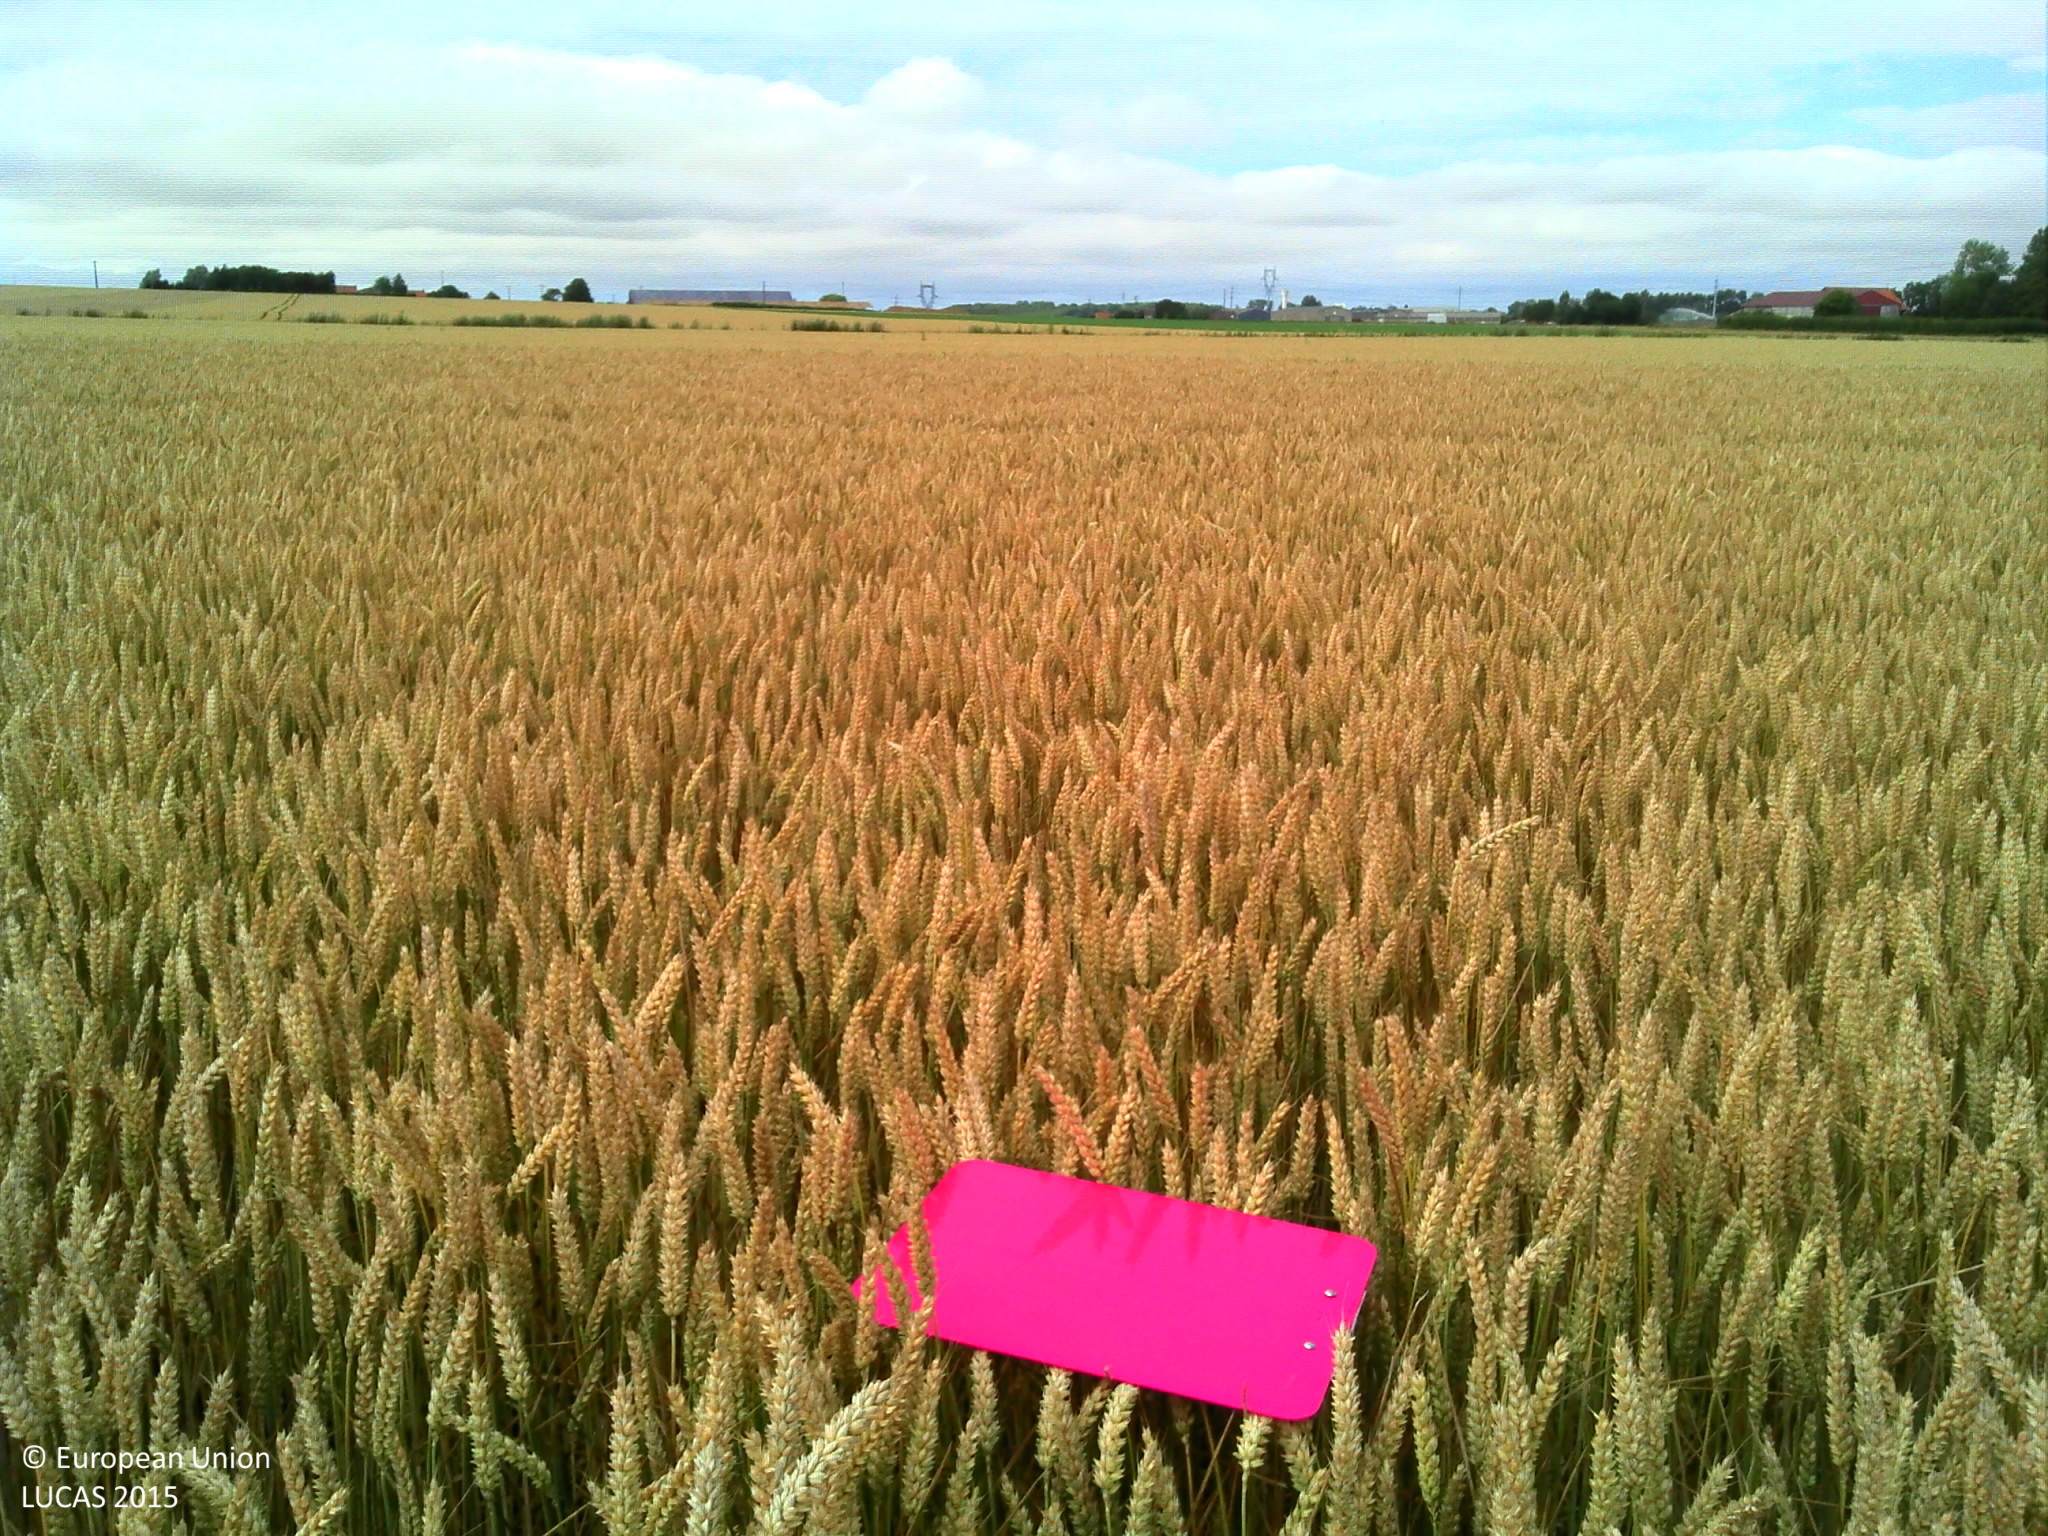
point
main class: Cropland
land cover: Common wheat
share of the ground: > 75 %
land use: Agriculture (excluding fallow land and kitchen gardens)
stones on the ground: < 10 %
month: July
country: FR
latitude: 50.8253
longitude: 2.2773
